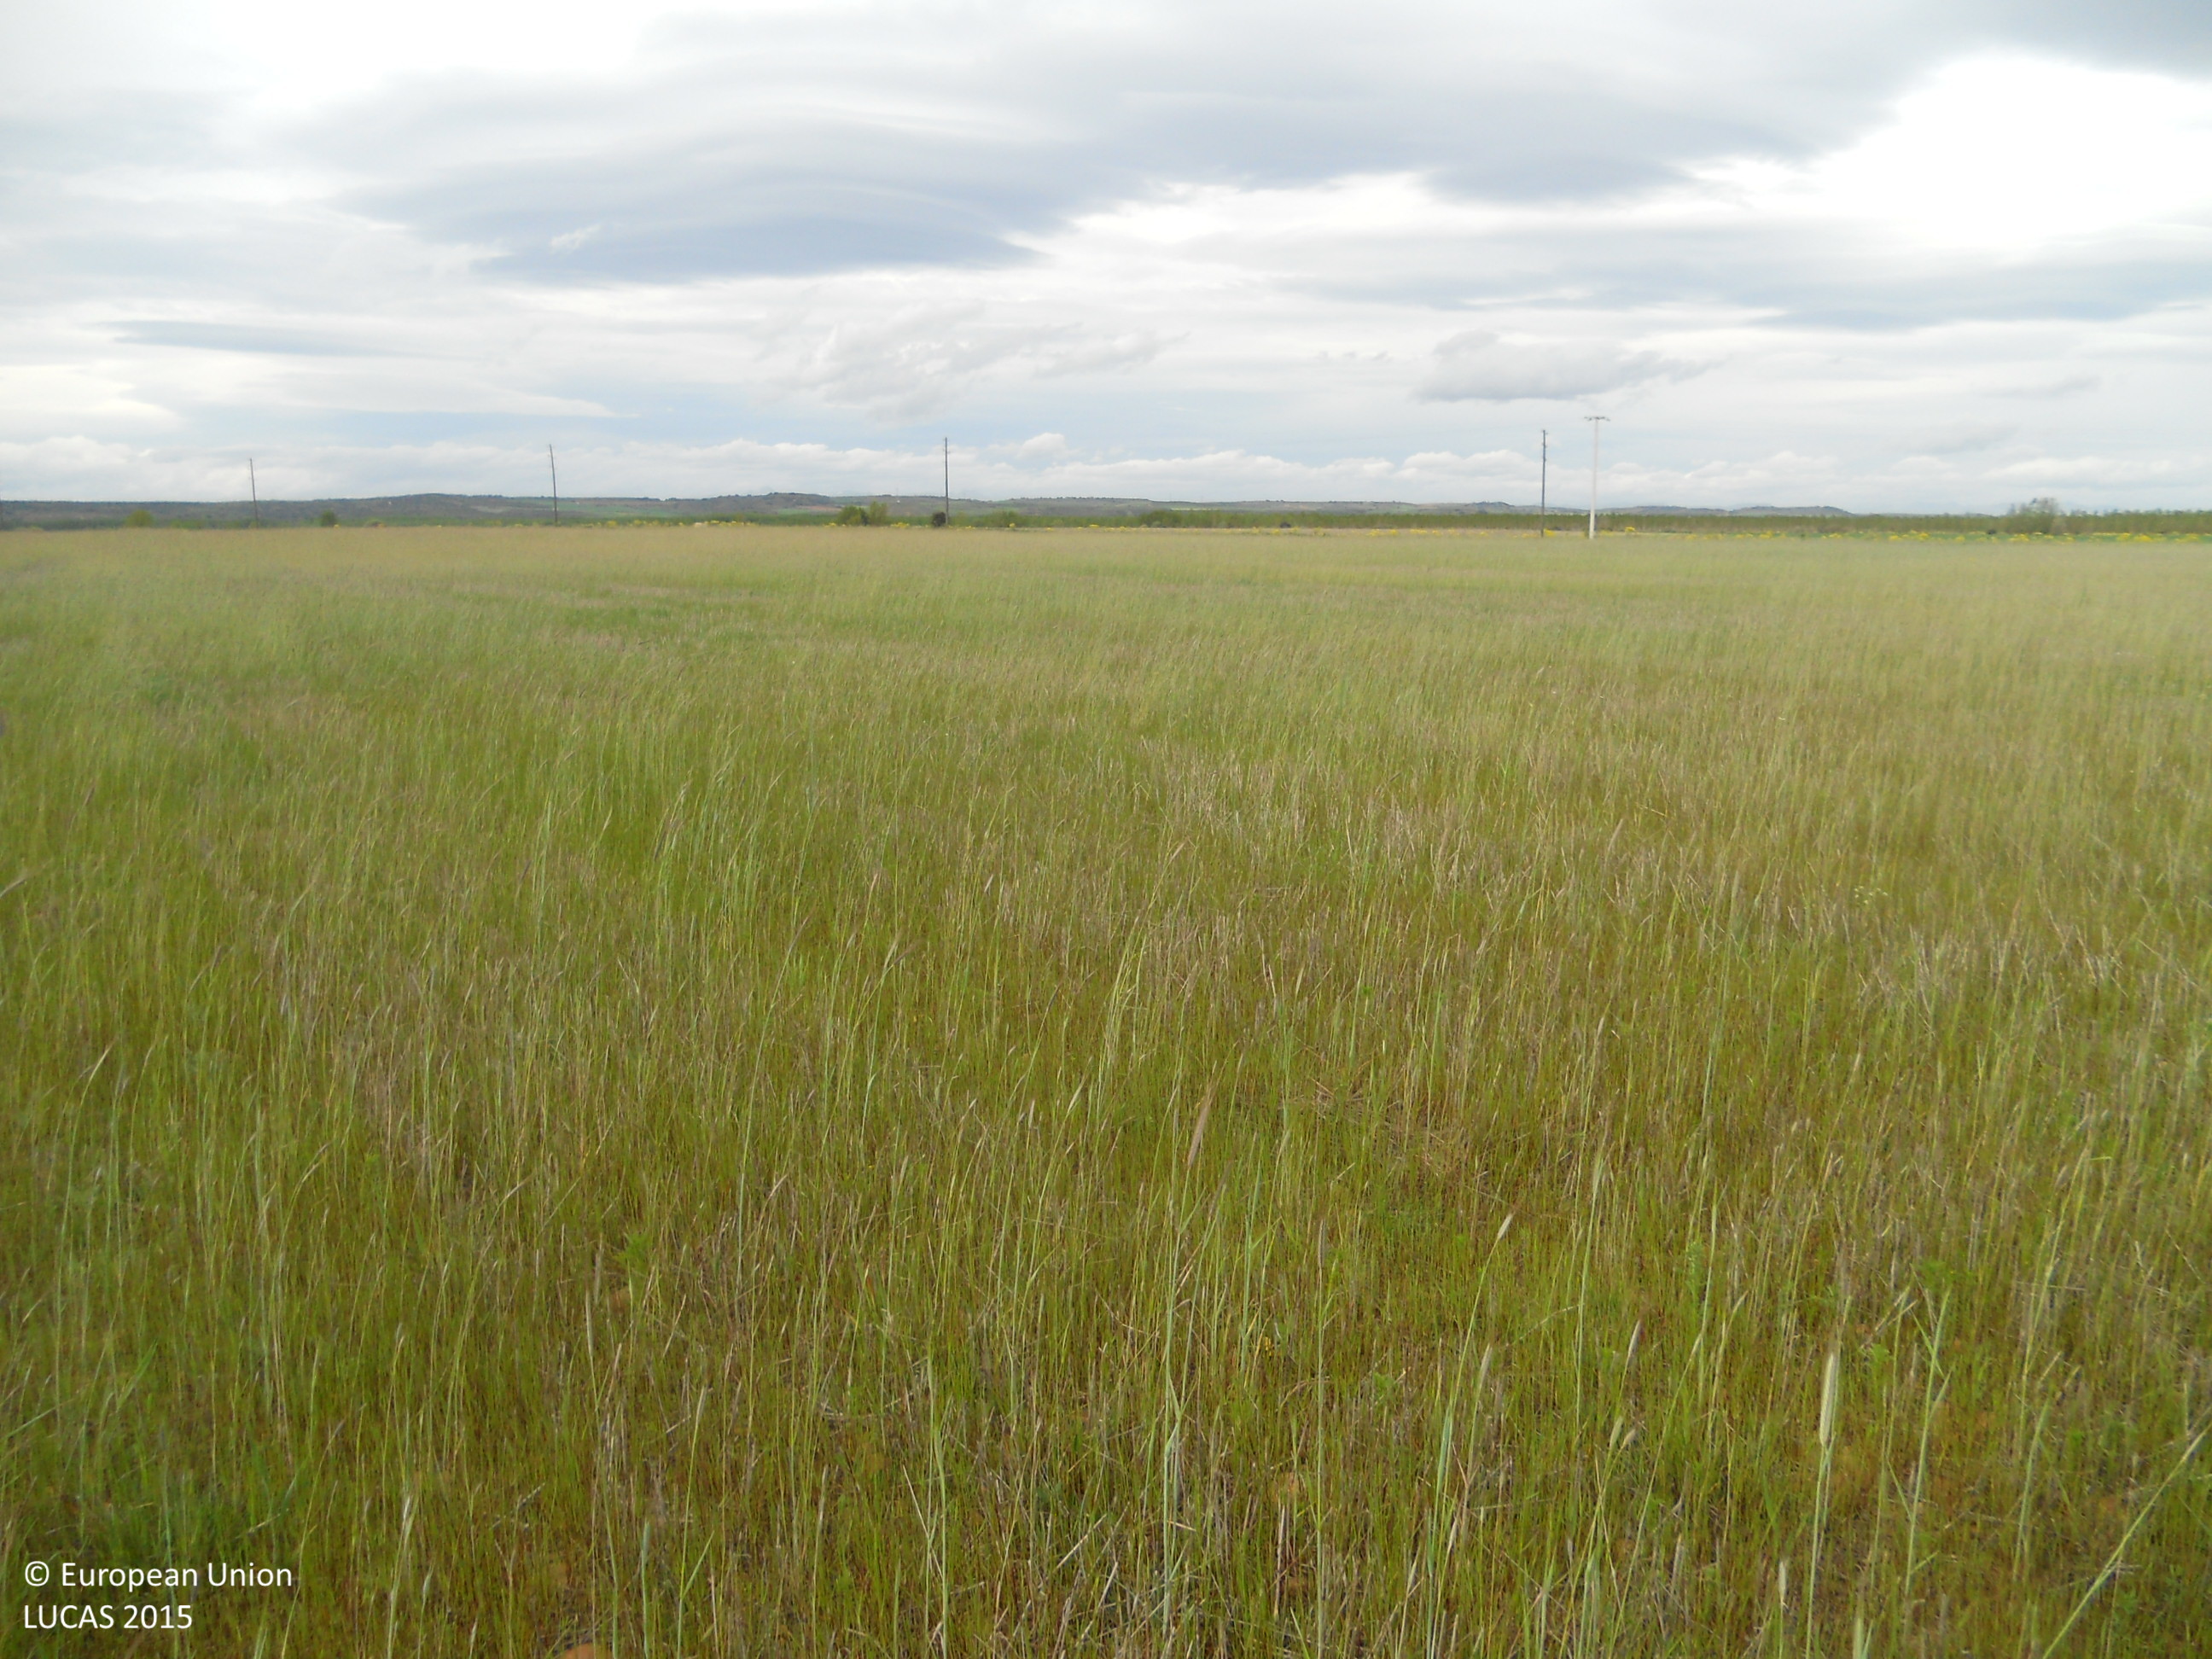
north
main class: Cropland
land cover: Rye
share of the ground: 10 - 25 %
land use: Agriculture (excluding fallow land and kitchen gardens)
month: May
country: ES
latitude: 42.5050
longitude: -5.3396
